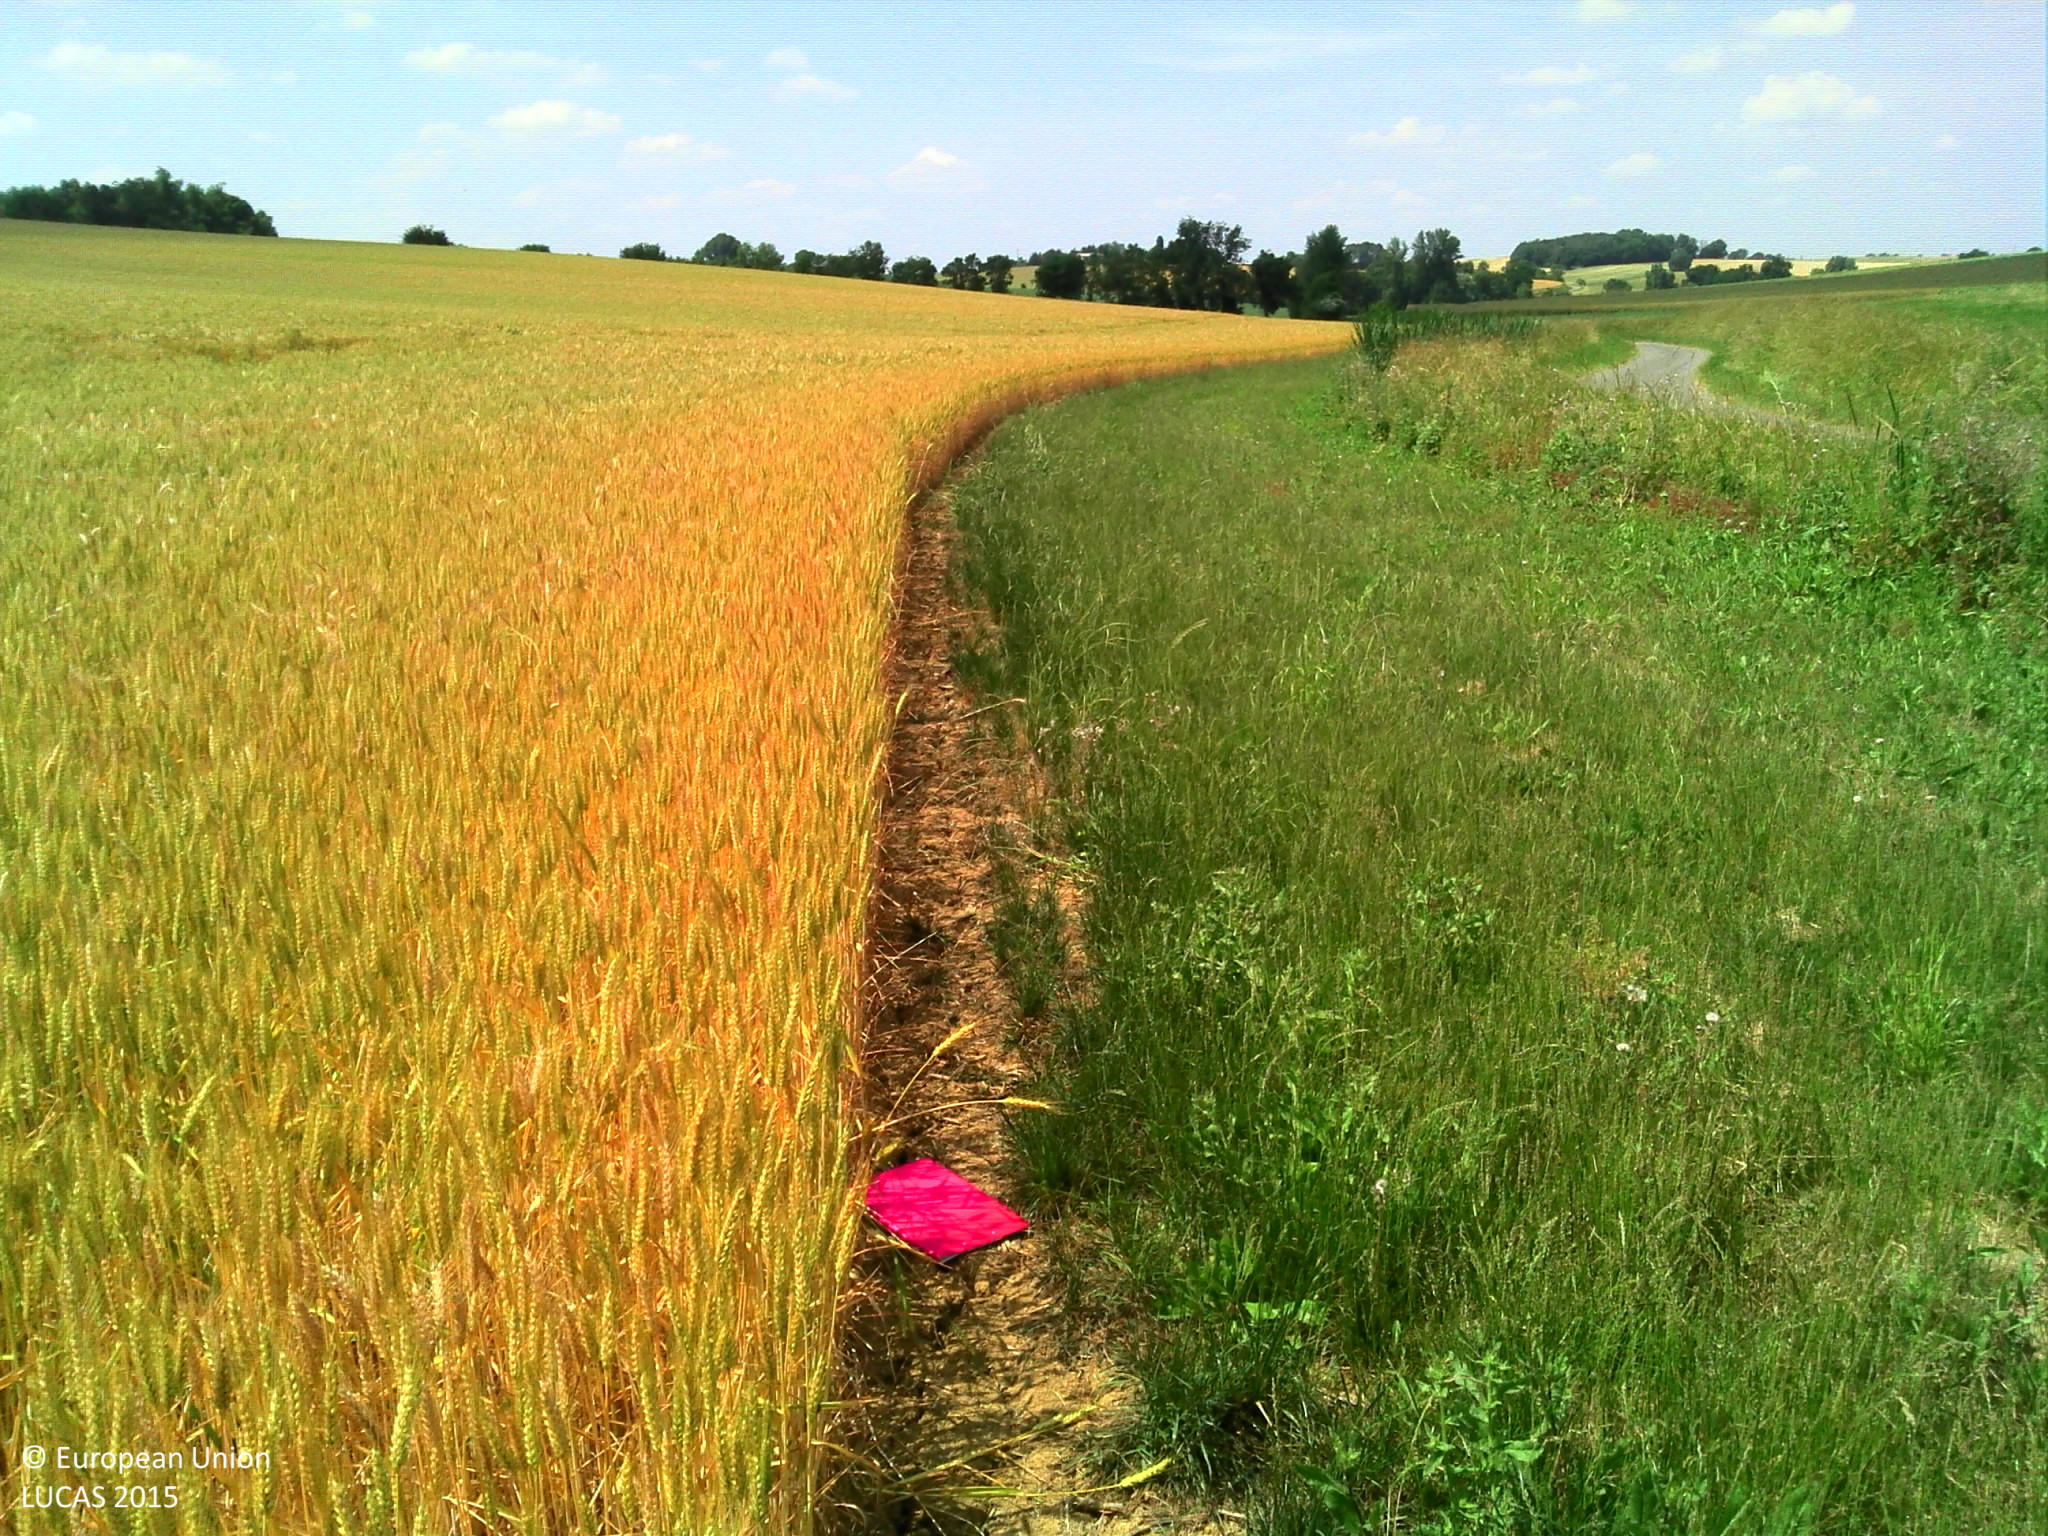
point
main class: Grassland
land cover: Grassland without tree/shrub cover
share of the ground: > 75 %
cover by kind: herbaceous plants 100 %
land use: Agriculture (excluding fallow land and kitchen gardens)
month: June
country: FR
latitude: 43.7547
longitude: 0.7453
